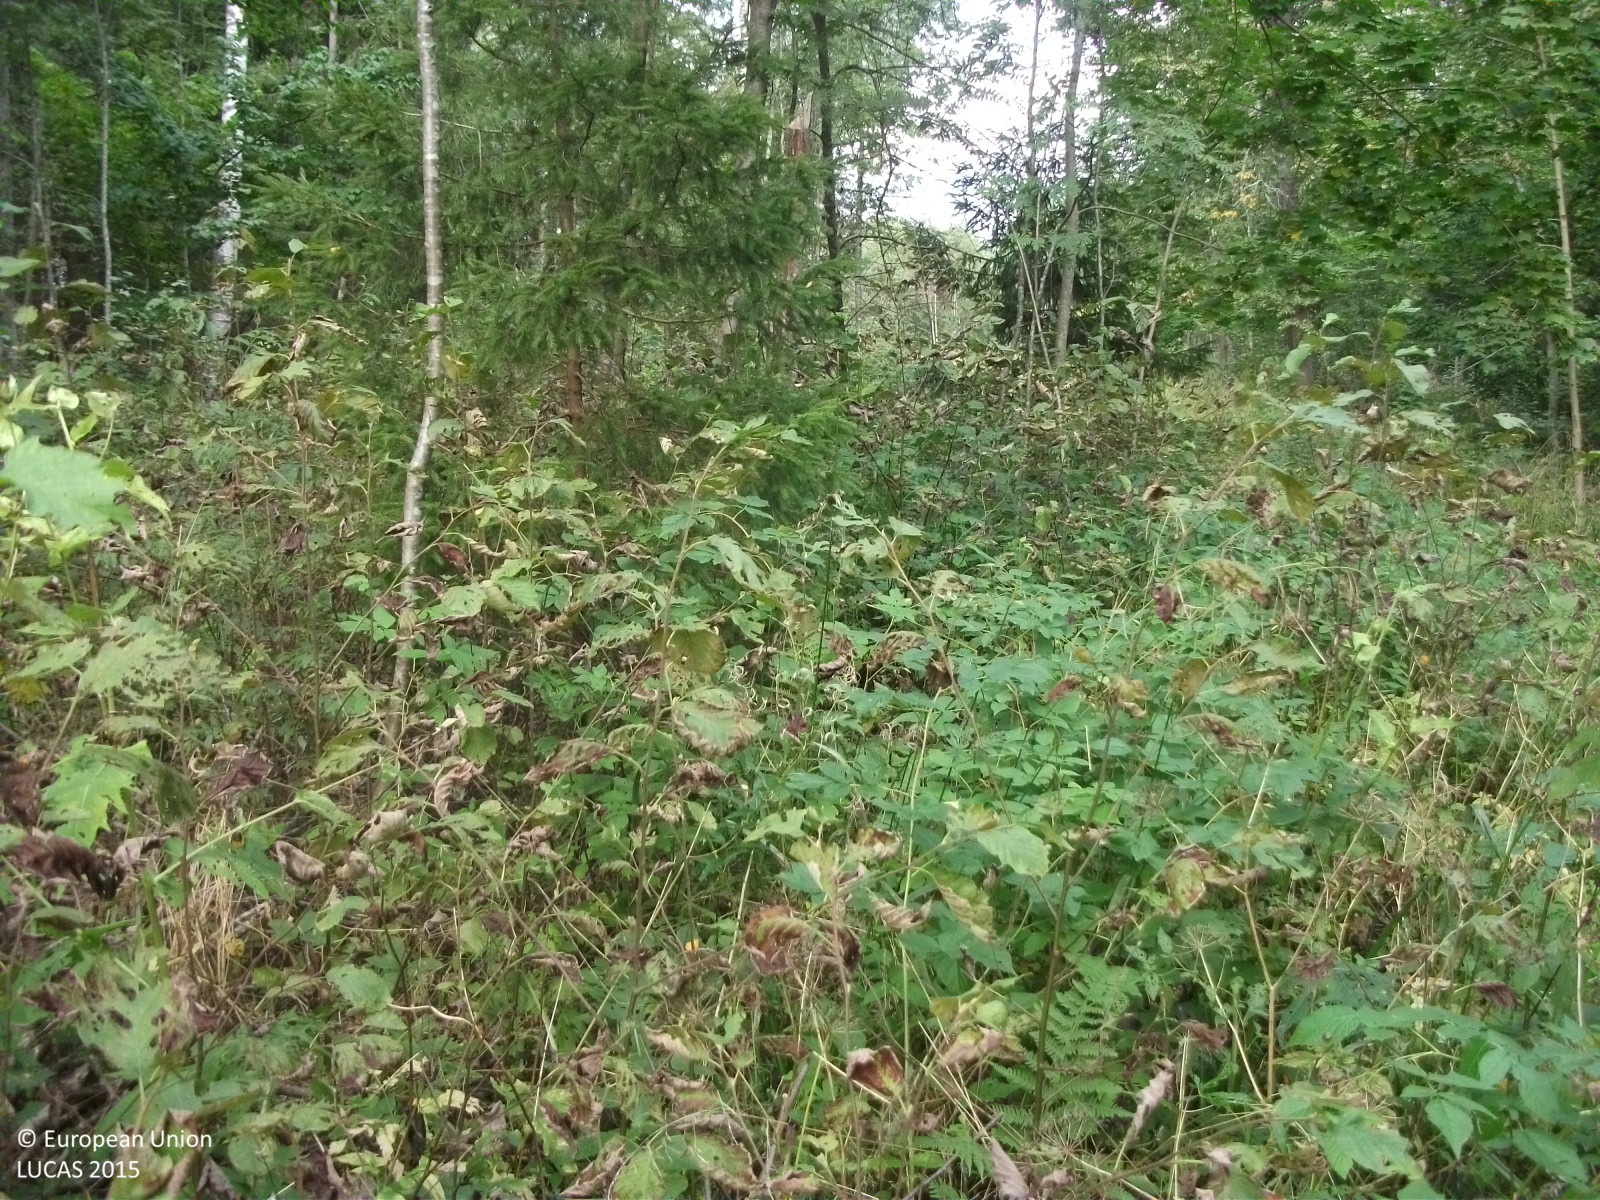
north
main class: Woodland
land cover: Broadleaved woodland
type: non-riverine alder, birch or aspen forest
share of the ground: 50 - 75 %
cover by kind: broadleaved forest trees 70 %, shrubs 20 %, coniferous forest trees 5 %, herbaceous plants 5 %
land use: Semi-natural and natural areas not in use
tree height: > 5 m
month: September
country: LV
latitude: 57.9139
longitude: 24.9005
